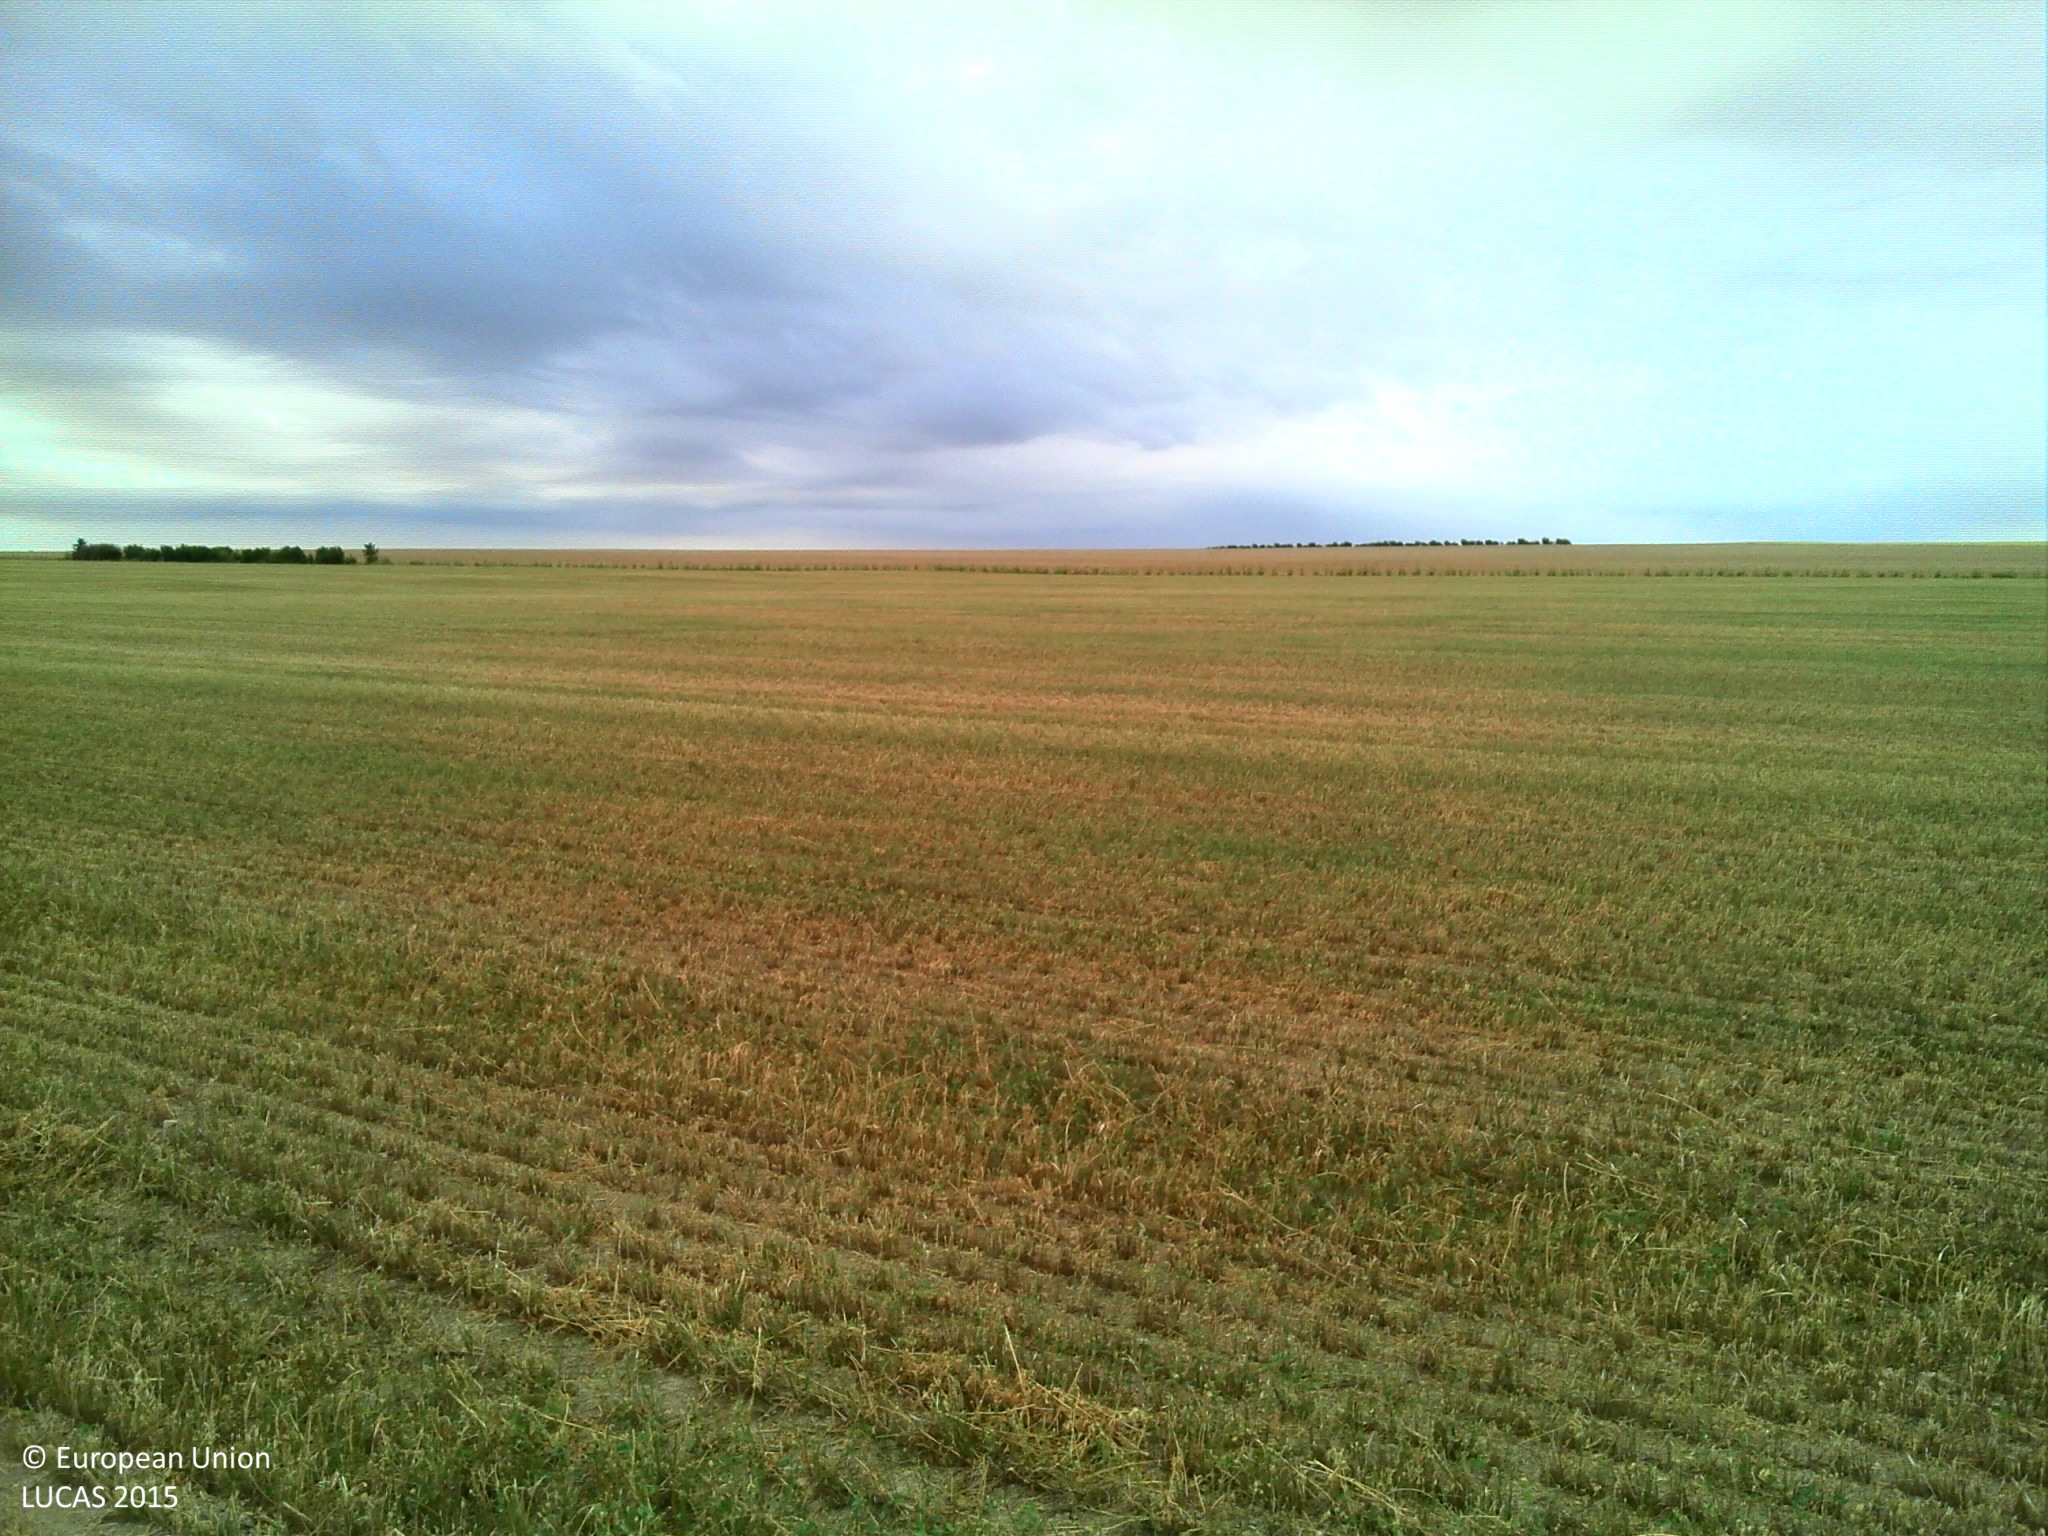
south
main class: Cropland
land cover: Lucerne
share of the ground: > 75 %
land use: Agriculture (excluding fallow land and kitchen gardens)
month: July
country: FR
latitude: 49.3278
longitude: 4.0923
